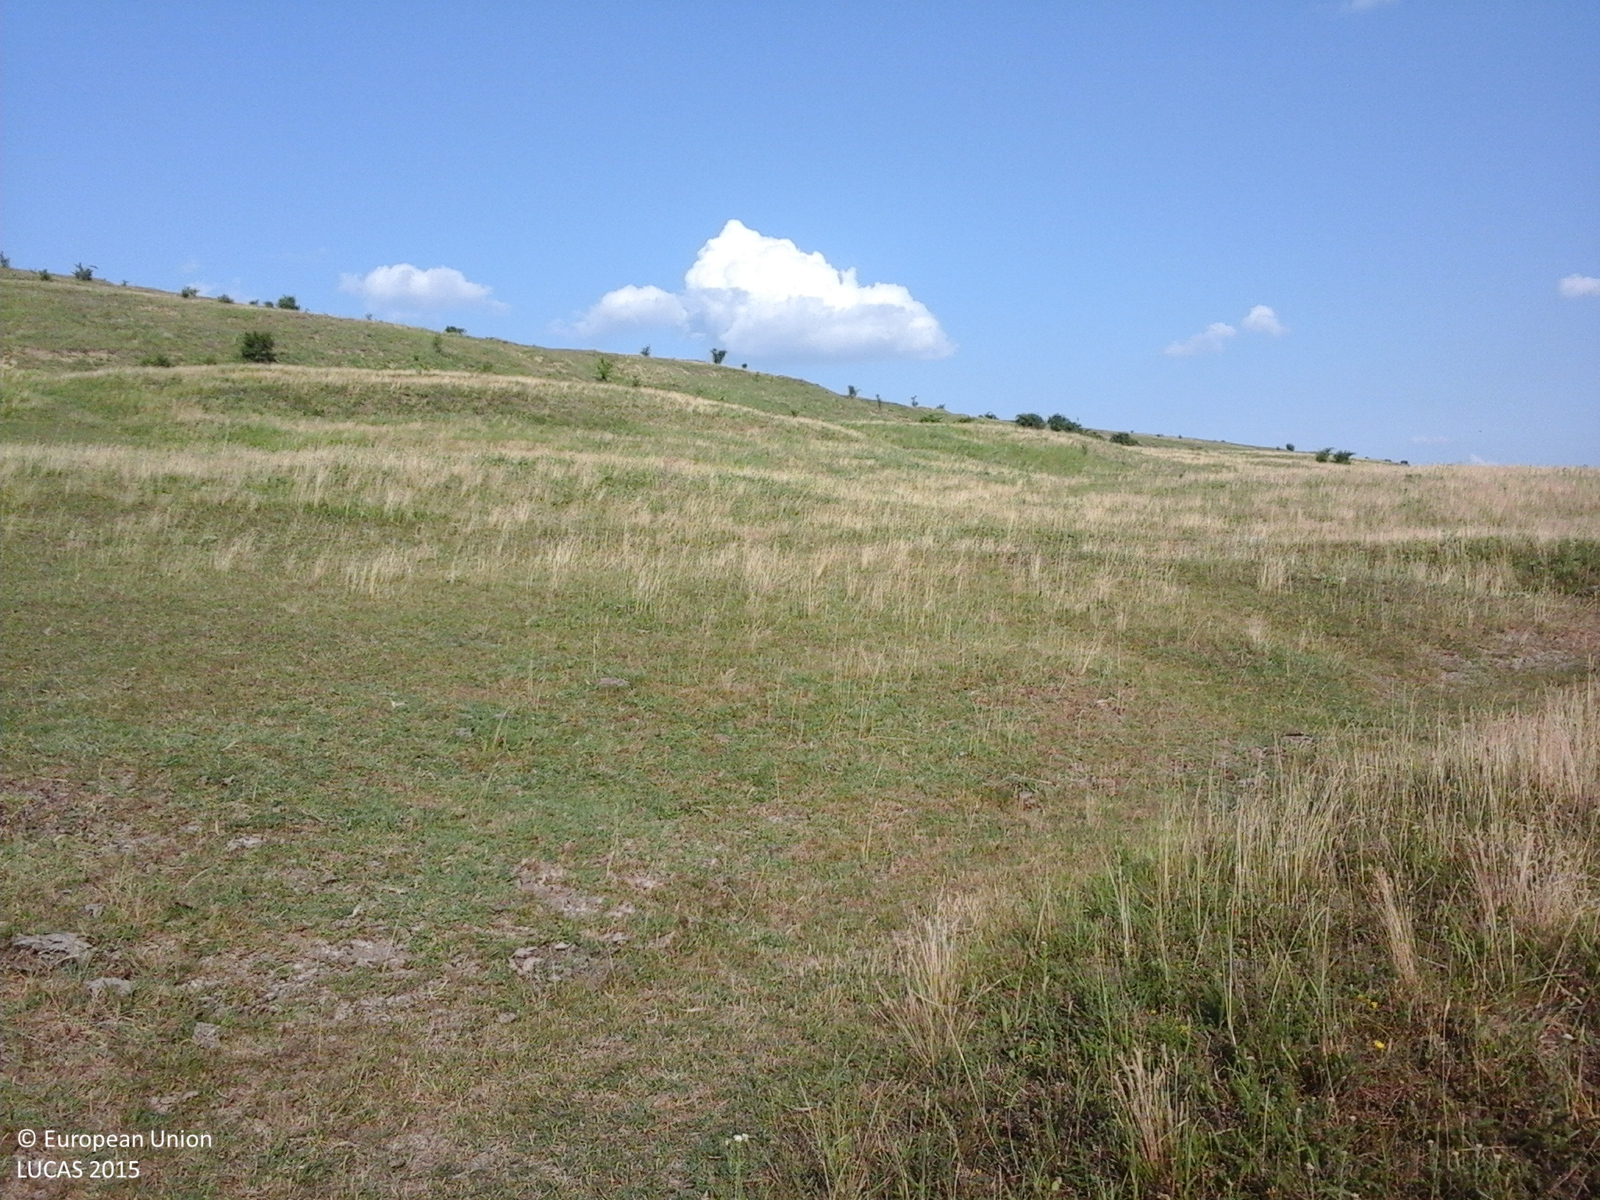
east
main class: Grassland
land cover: Grassland without tree/shrub cover
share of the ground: > 75 %
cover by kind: herbaceous plants 100 %
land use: Agriculture (excluding fallow land and kitchen gardens)
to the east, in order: Grassland without tree/shrub cover
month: June
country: RO
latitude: 47.5870
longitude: 26.8949
